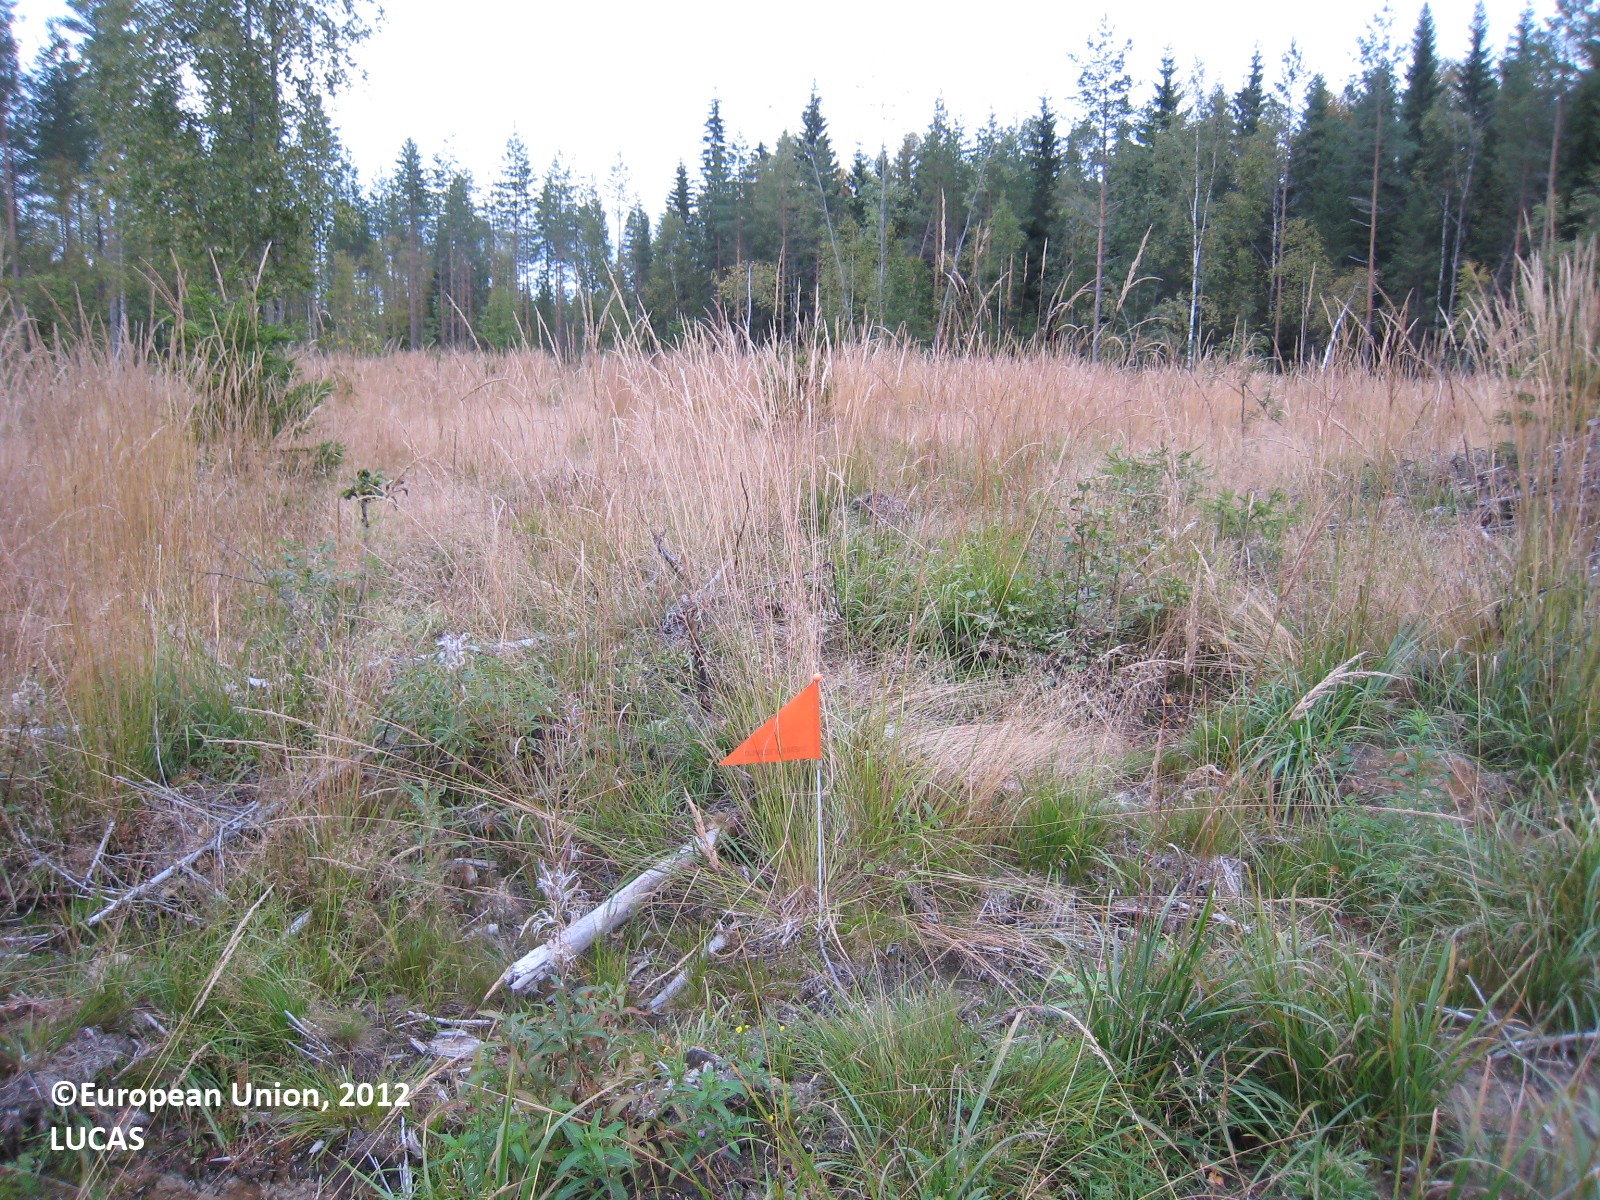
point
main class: Grassland
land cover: Grassland with sparse tree/shrub cover
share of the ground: > 75 %
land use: Forestry
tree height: < 5 m
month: August
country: FI
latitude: 62.3371
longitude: 27.3279
